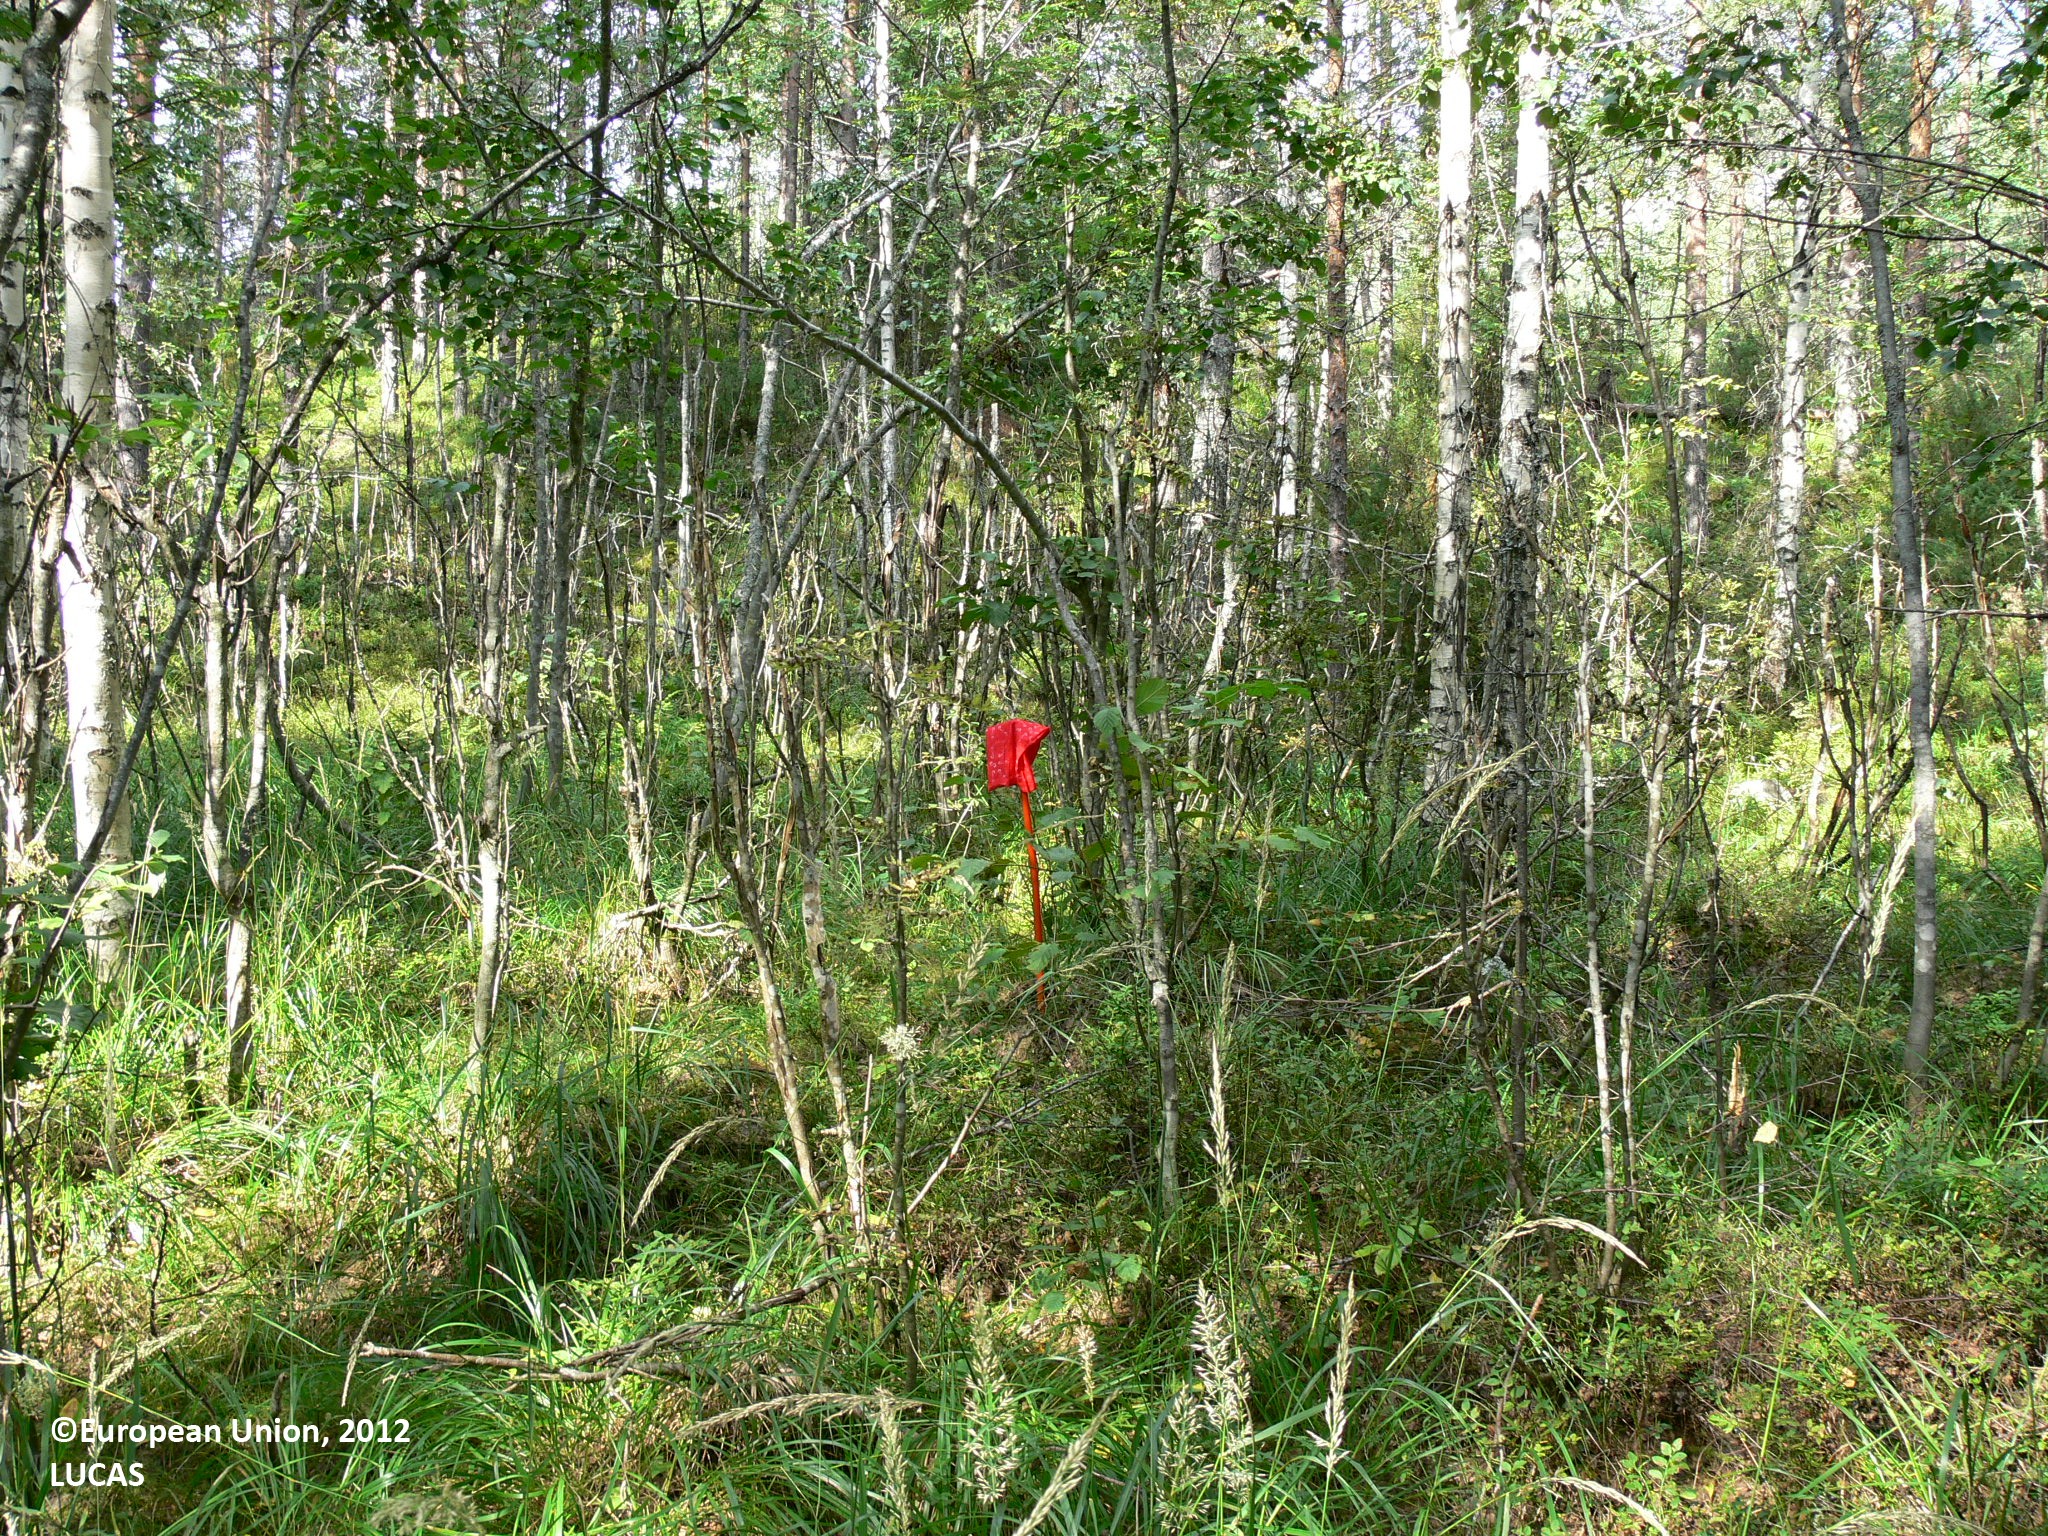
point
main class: Woodland
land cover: Other mixed woodland
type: boreal forest
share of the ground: > 75 %
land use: Amenities, museums, leisure
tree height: > 5 m
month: August
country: FI
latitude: 63.0149
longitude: 29.9463
